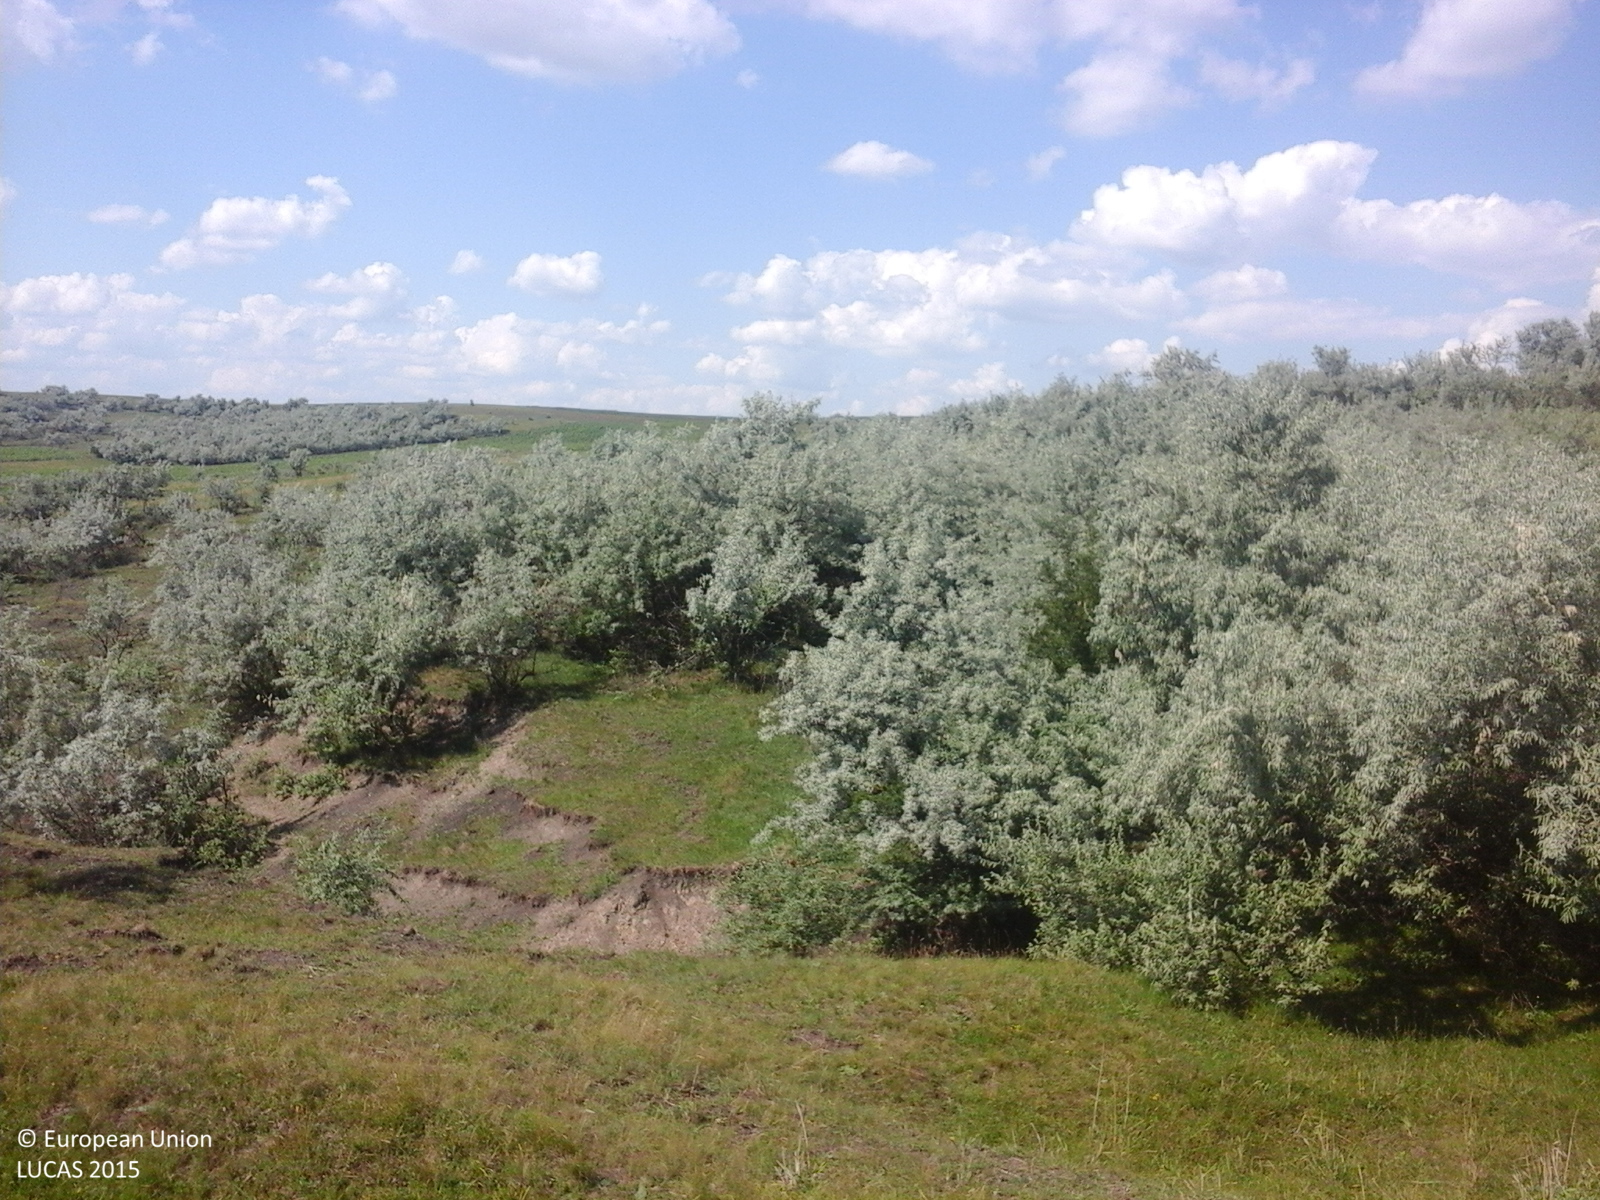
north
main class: Grassland
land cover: Grassland with sparse tree/shrub cover
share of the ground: > 75 %
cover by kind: herbaceous plants 85 %, shrubs 10 %, broadleaved forest trees 5 %
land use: Agriculture (excluding fallow land and kitchen gardens)
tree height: < 5 m
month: June
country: RO
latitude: 48.1719
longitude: 26.6785
